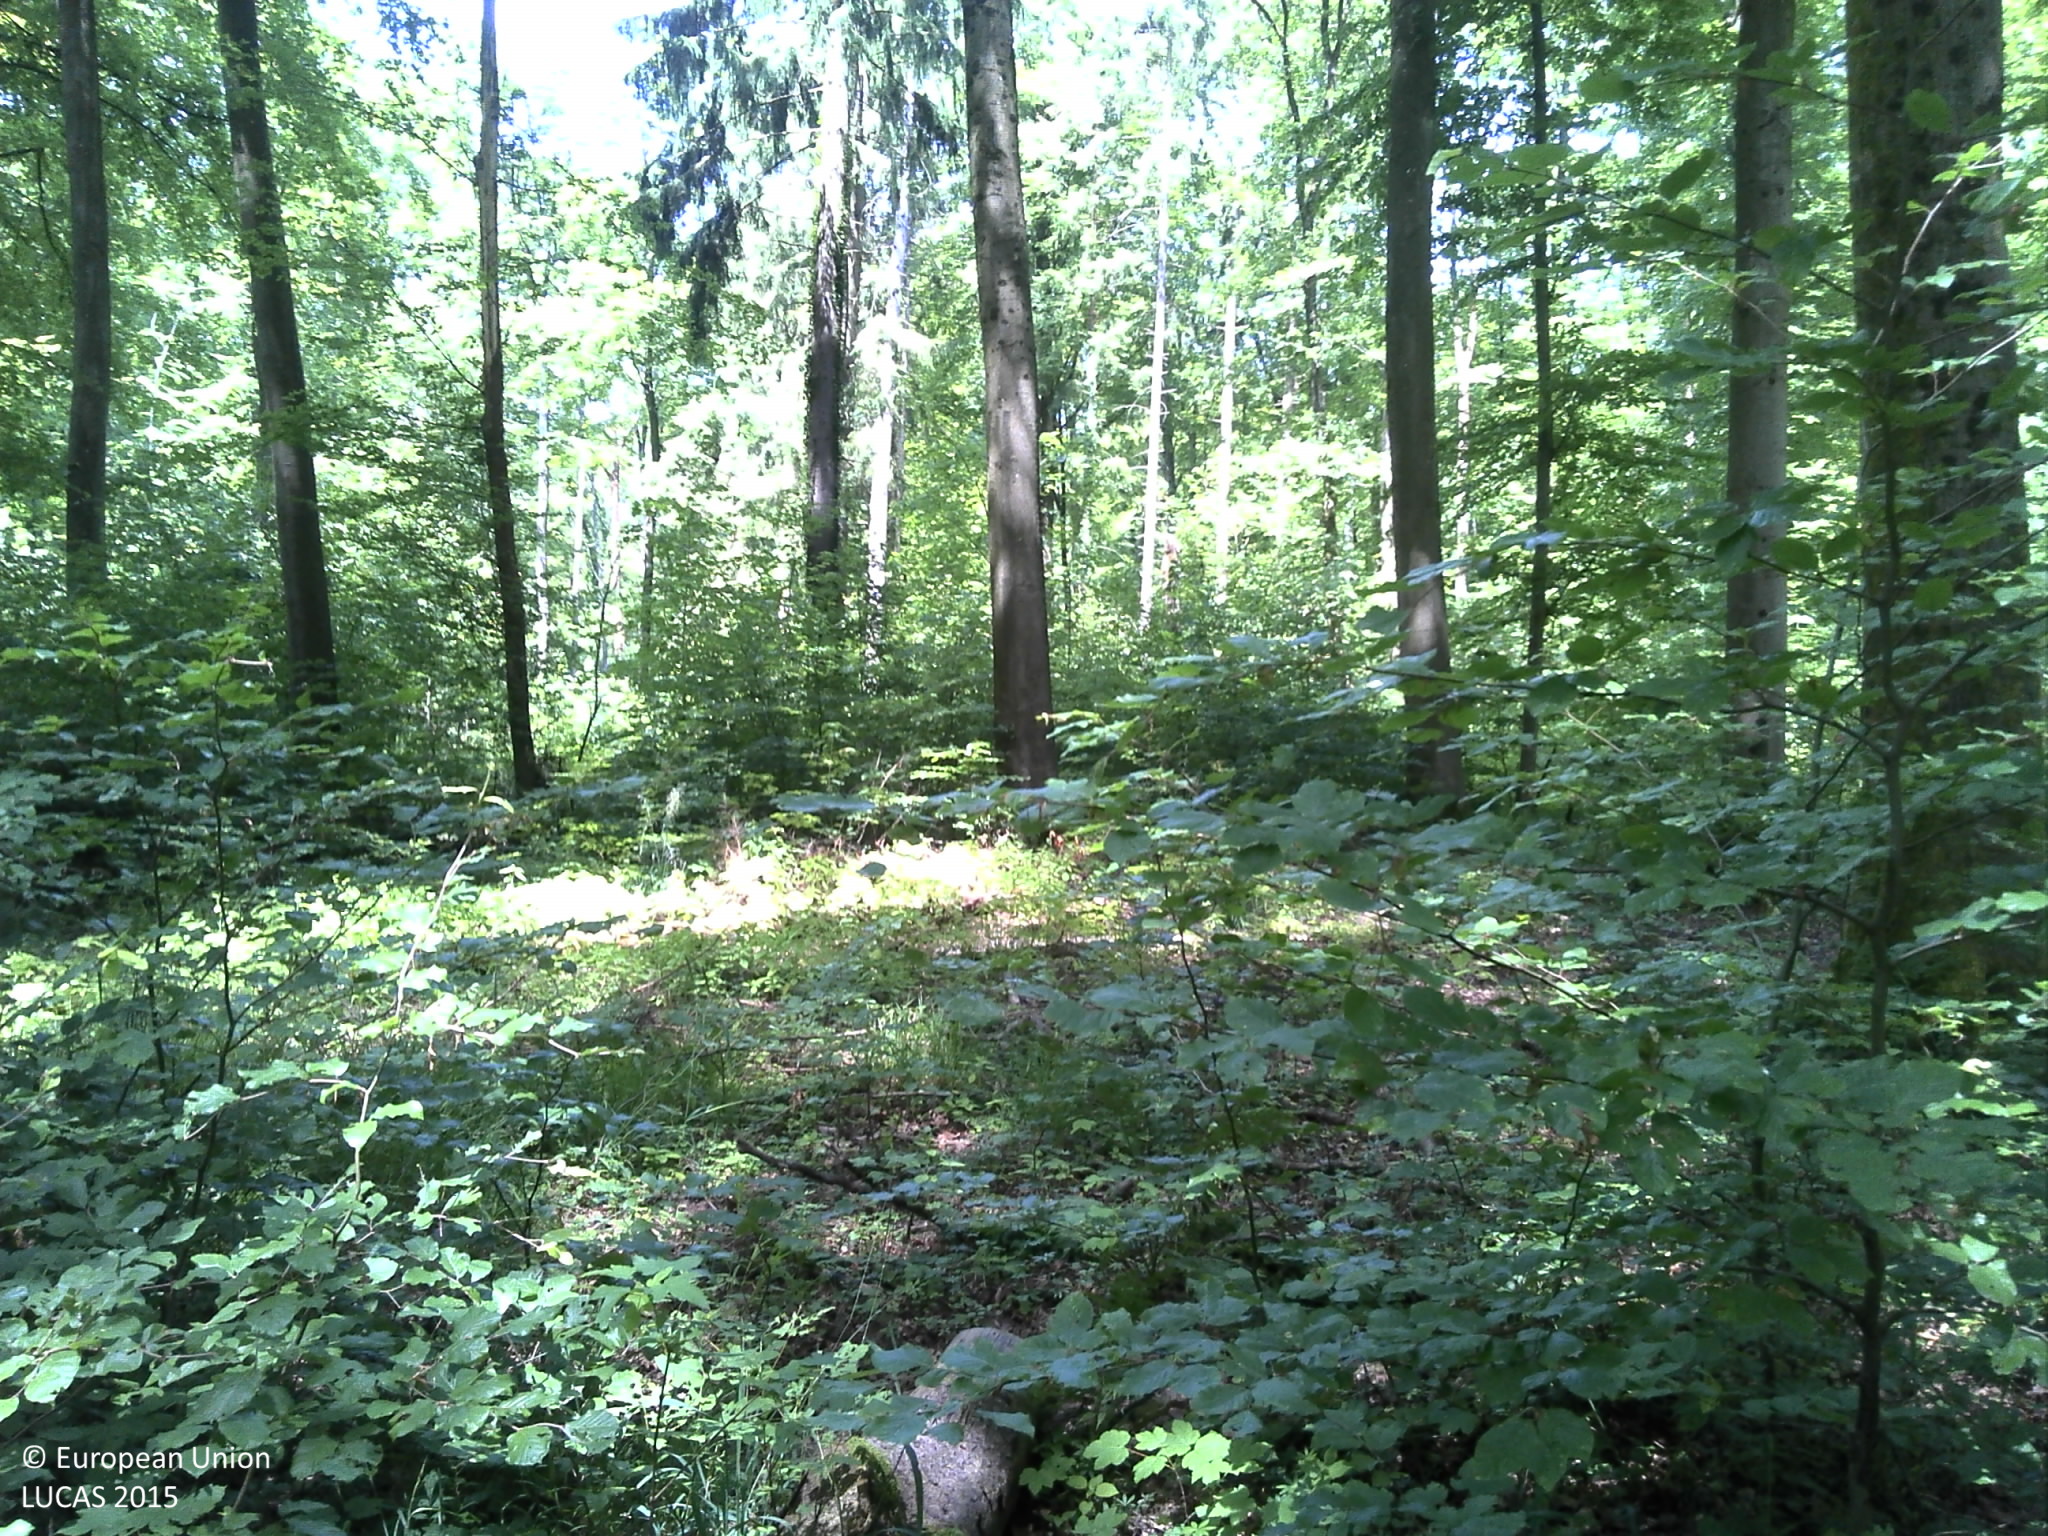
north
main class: Woodland
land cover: Broadleaved woodland
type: beech forest
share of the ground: > 75 %
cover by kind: broadleaved forest trees 80 %, coniferous forest trees 10 %, herbaceous plants 10 %
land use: Forestry
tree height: > 5 m
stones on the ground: < 10 %
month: June
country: FR
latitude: 49.2877
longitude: 6.0537
